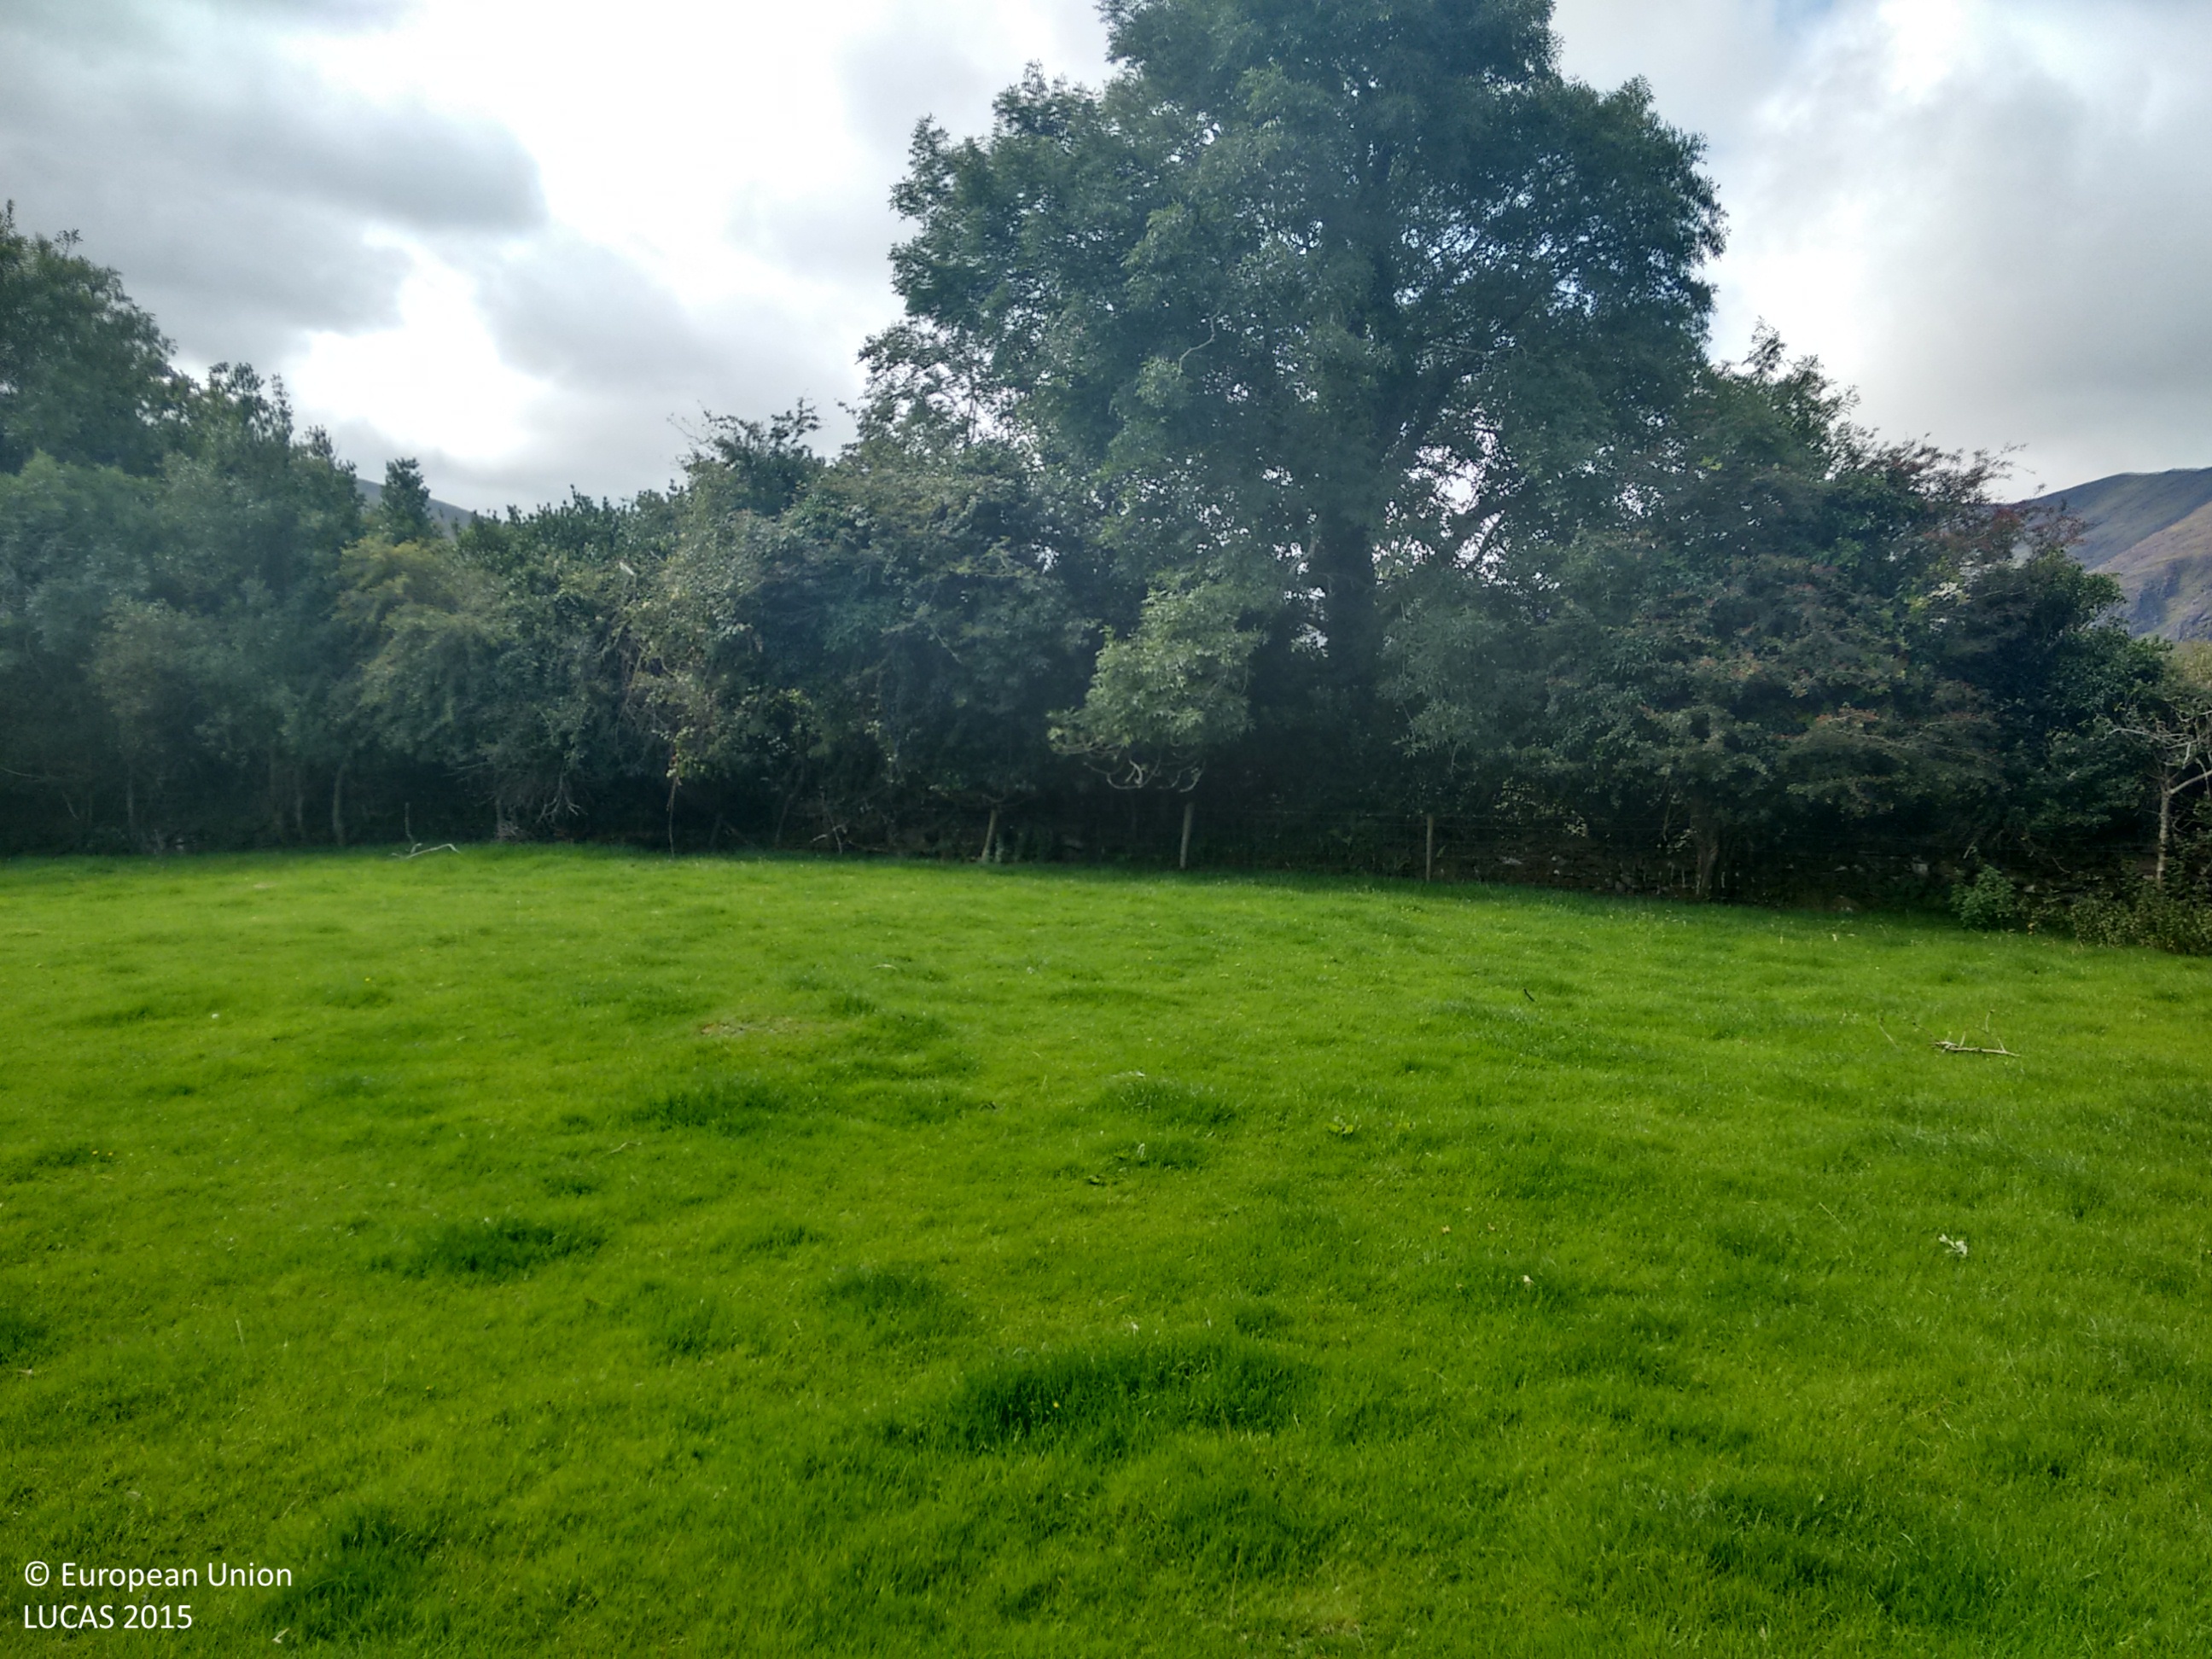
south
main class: Grassland
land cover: Grassland without tree/shrub cover
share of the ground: > 75 %
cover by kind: herbaceous plants 95 %, shrubs 5 %
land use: Agriculture (excluding fallow land and kitchen gardens)
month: September
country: IE
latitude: 52.2308
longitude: -10.1893
